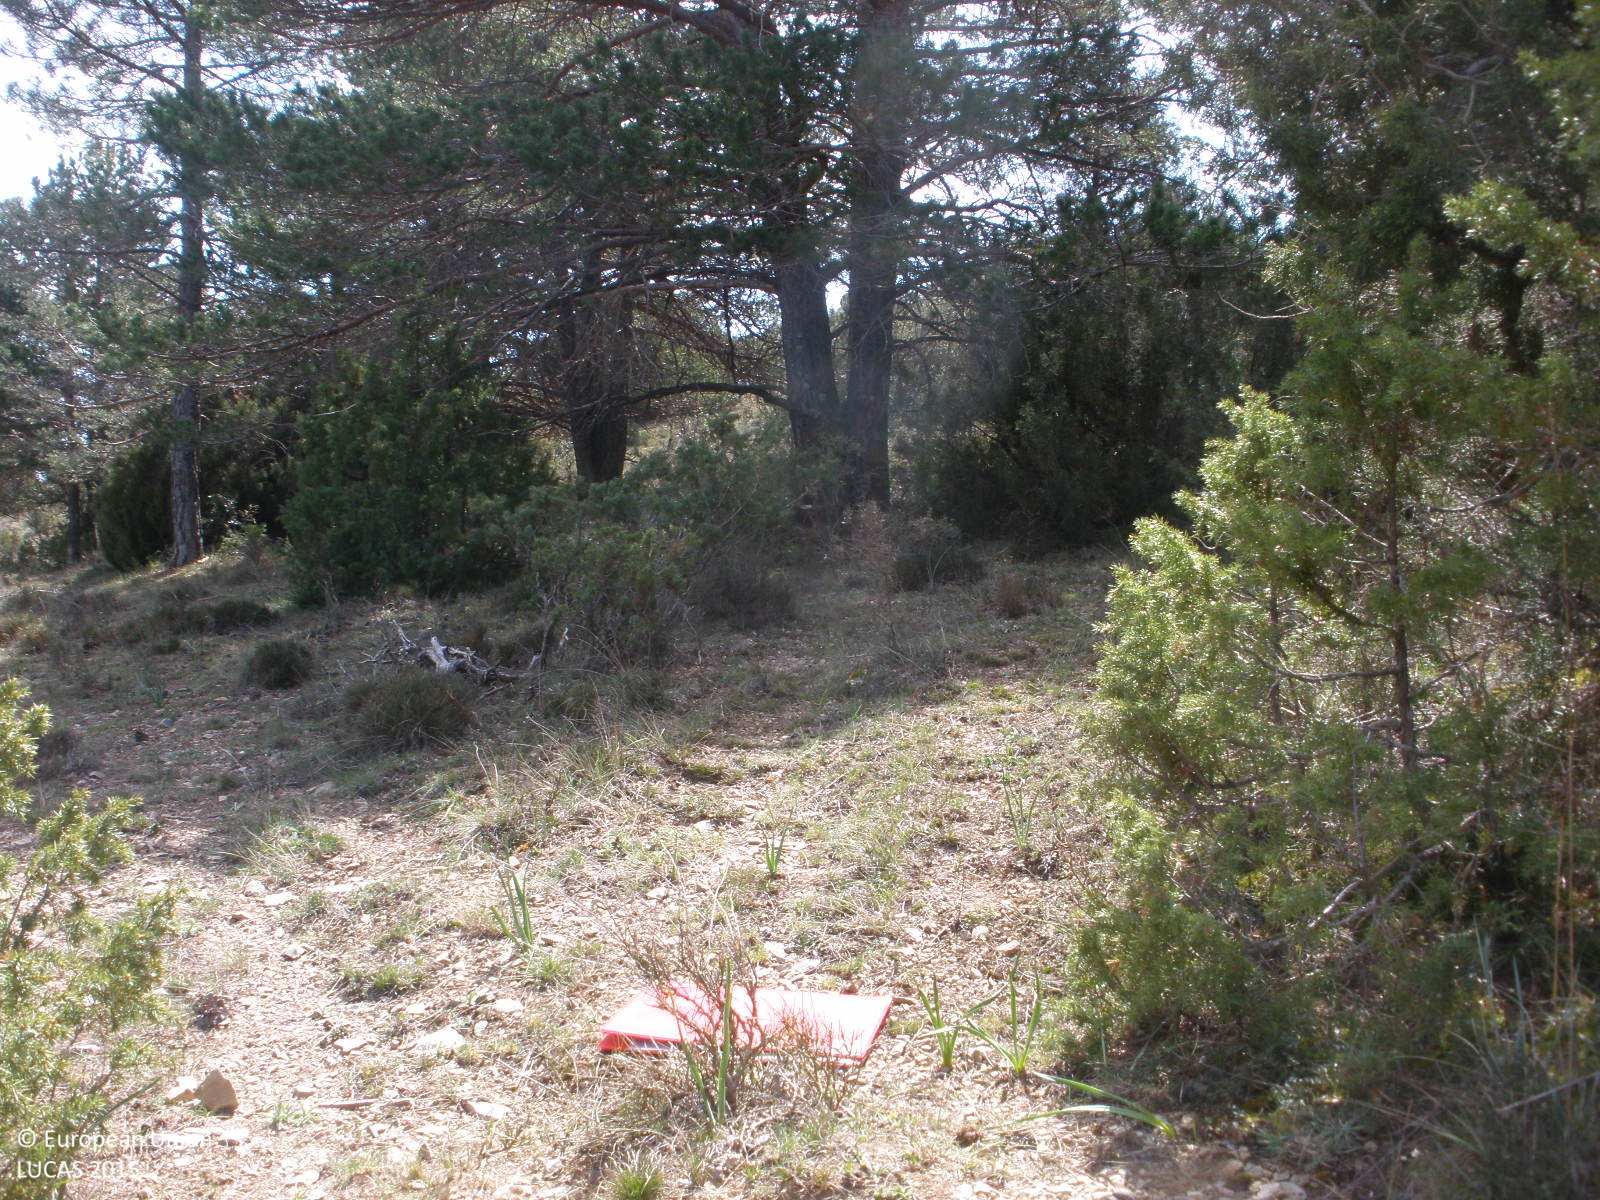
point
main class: Woodland
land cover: Pine dominated coniferous woodland
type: coniferous forest of the mediterranean region
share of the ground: > 75 %
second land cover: Grassland without tree/shrub cover
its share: > 75 %
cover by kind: coniferous forest trees 40 %, shrubs 30 %, herbaceous plants 20 %, consolidated bare surface 10 %
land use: Forestry
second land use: Agriculture (excluding fallow land and kitchen gardens)
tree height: > 5 m
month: April
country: ES
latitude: 40.2156
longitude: -0.9714
